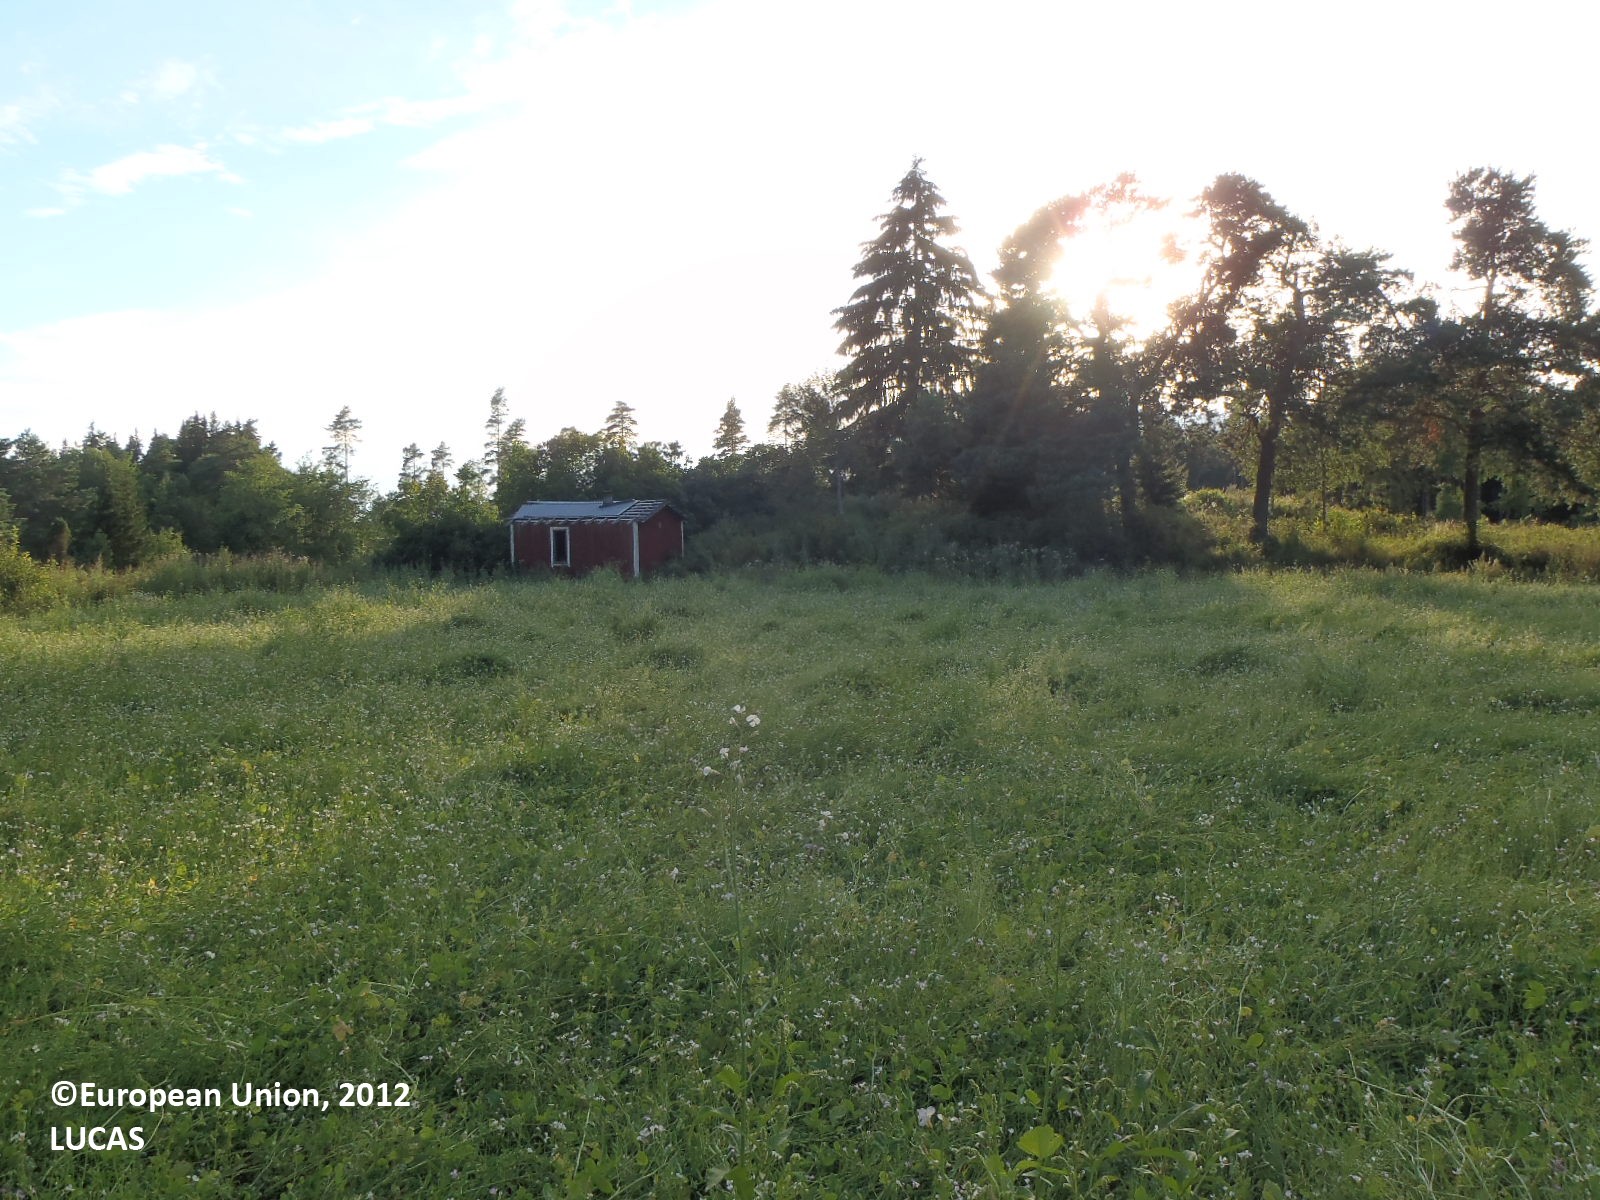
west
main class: Cropland
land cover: Temporary grasslands
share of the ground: > 75 %
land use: Agriculture (excluding fallow land and kitchen gardens)
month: August
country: FI
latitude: 60.2840
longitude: 22.2392
